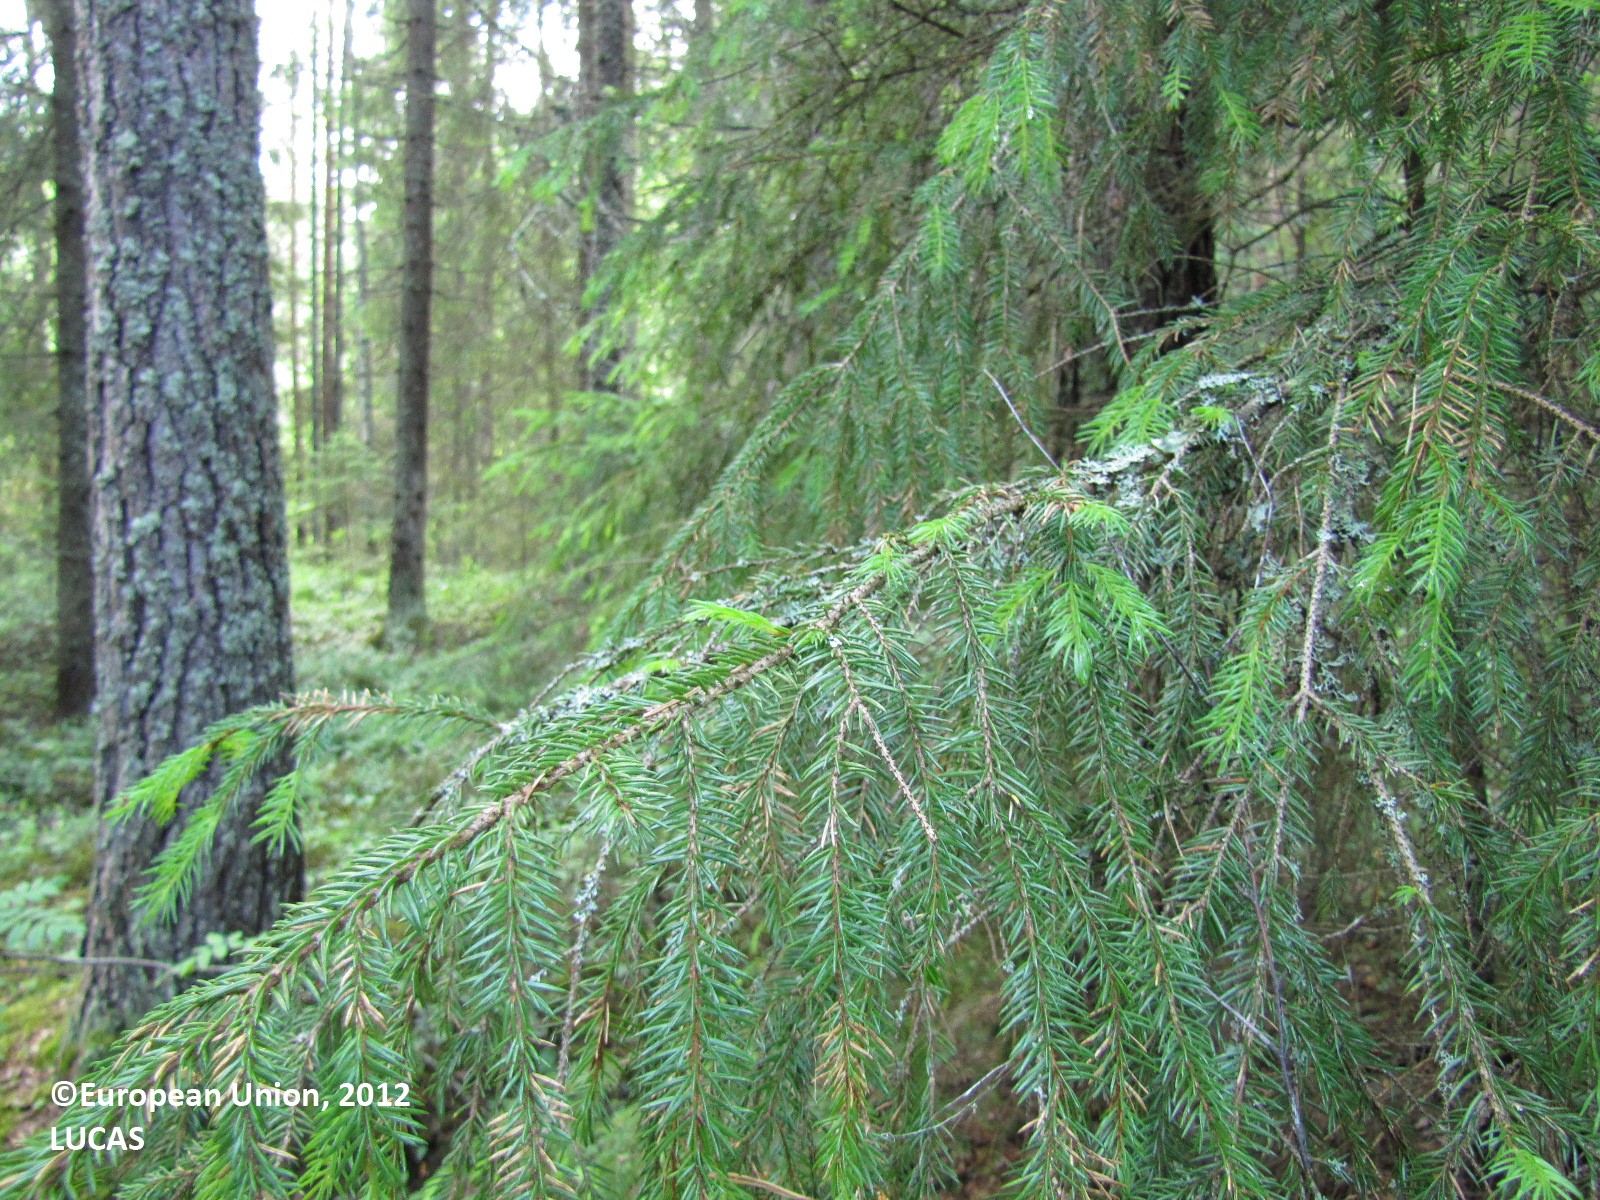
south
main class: Woodland
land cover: Spruce dominated coniferous woodland
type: boreal forest
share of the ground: 50 - 75 %
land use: Forestry
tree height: > 5 m
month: June
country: FI
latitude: 61.3234
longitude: 24.6176
